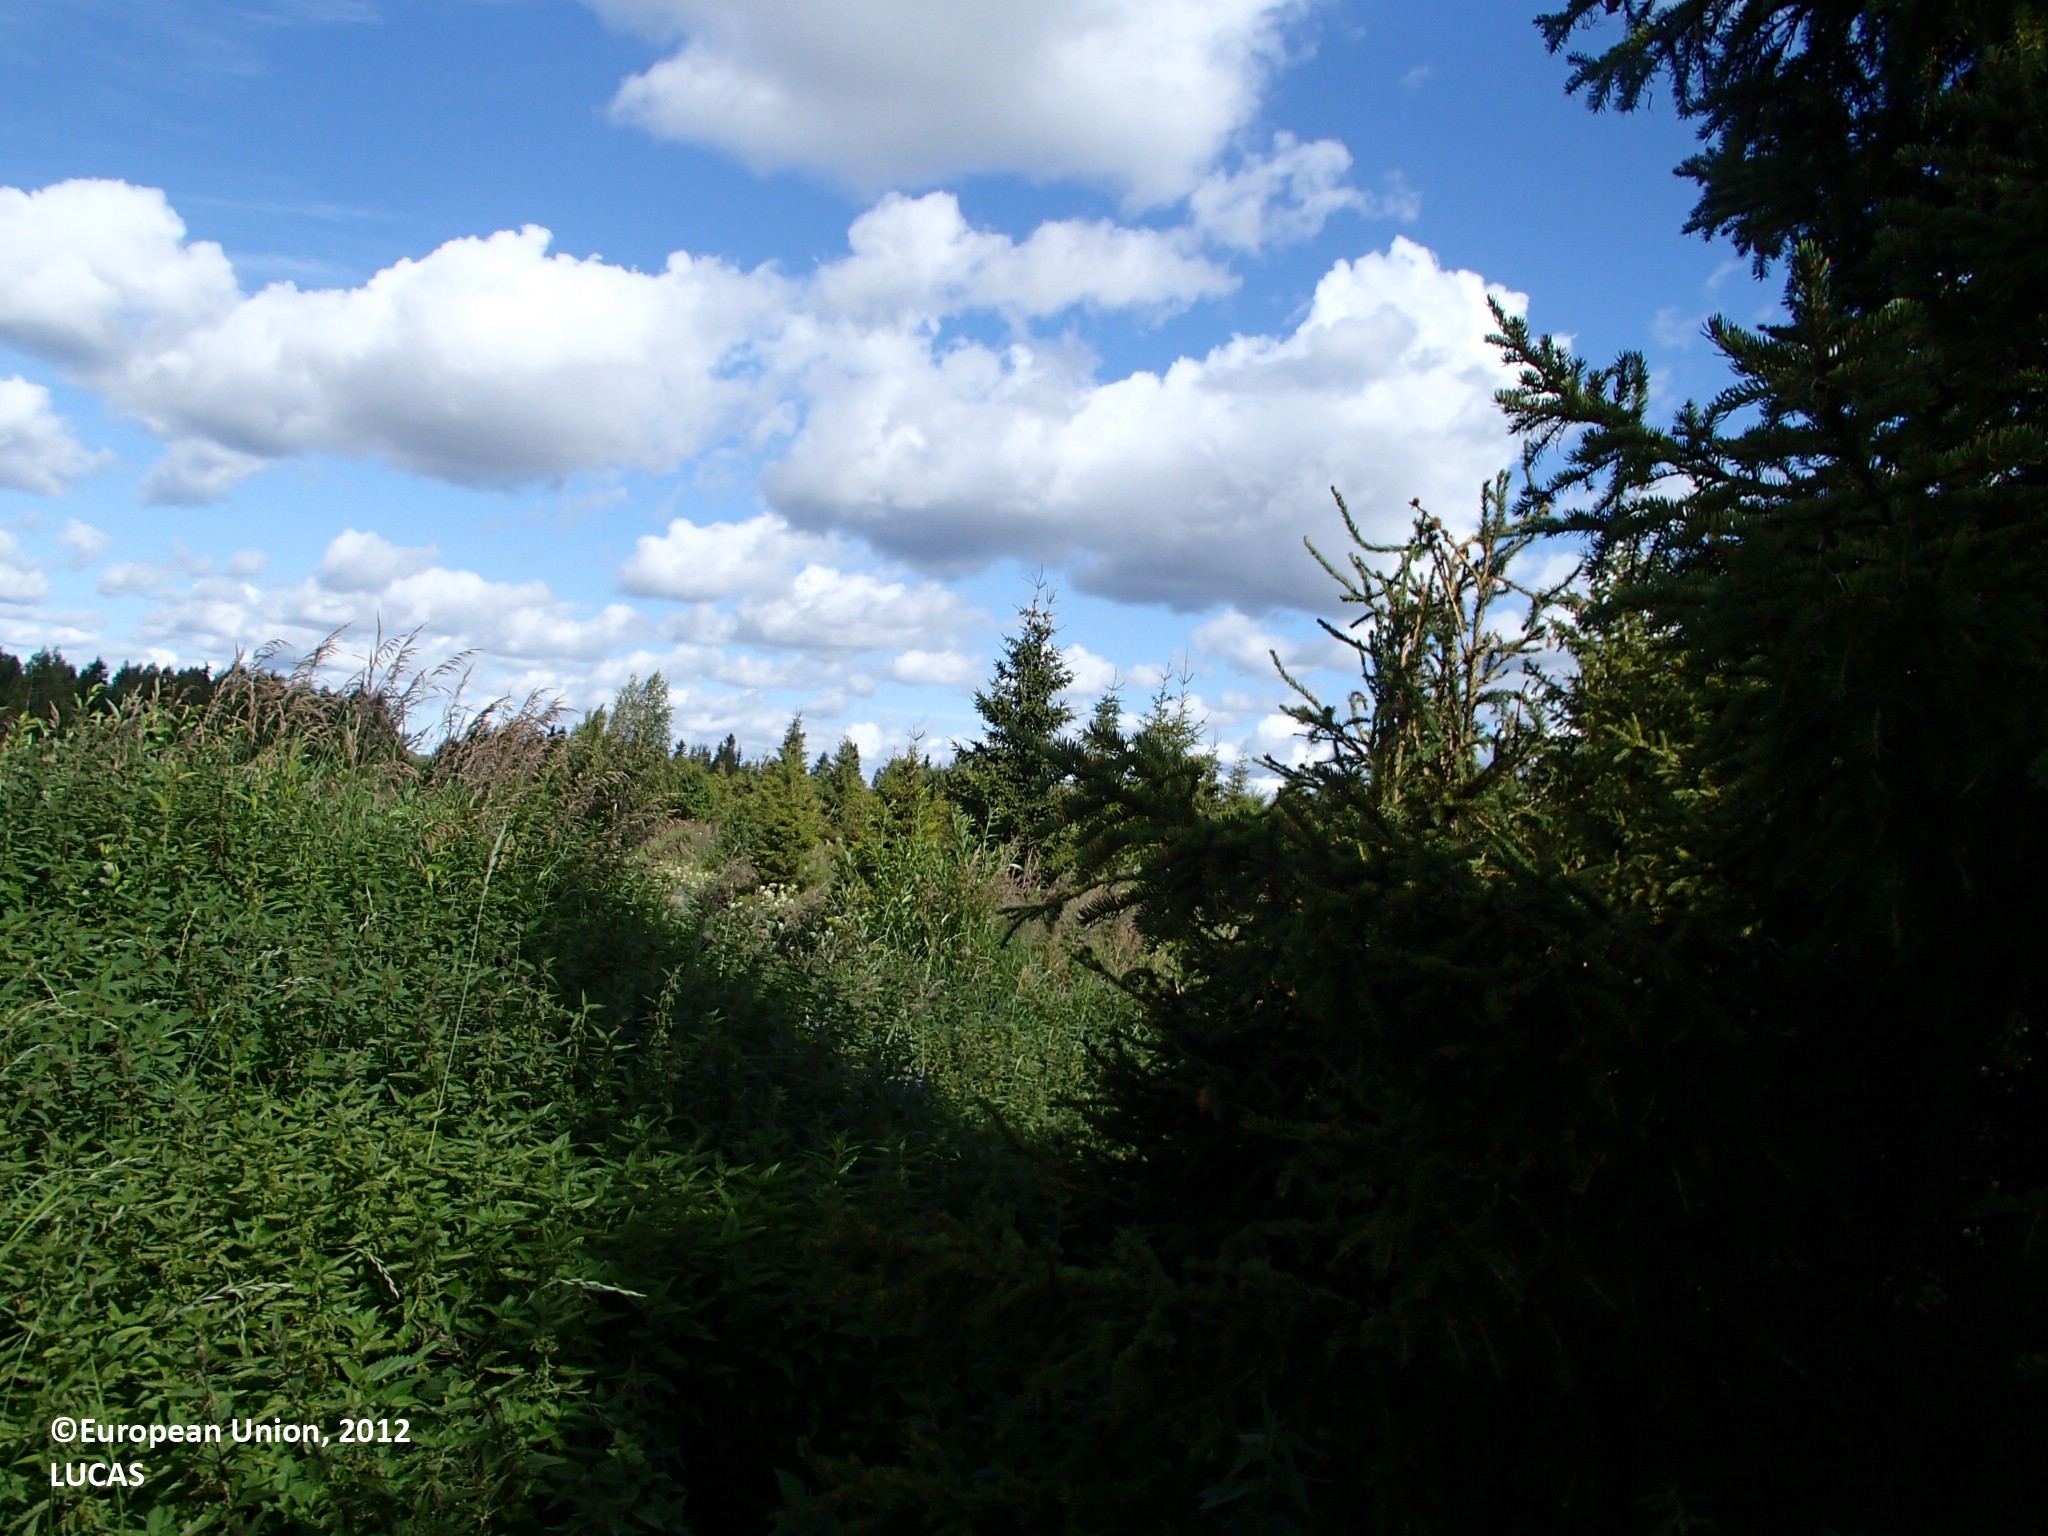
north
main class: Woodland
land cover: Spruce dominated coniferous woodland
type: boreal forest
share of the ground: 25 - 50 %
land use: Forestry
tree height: > 5 m
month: August
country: FI
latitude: 66.2372
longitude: 25.5249
